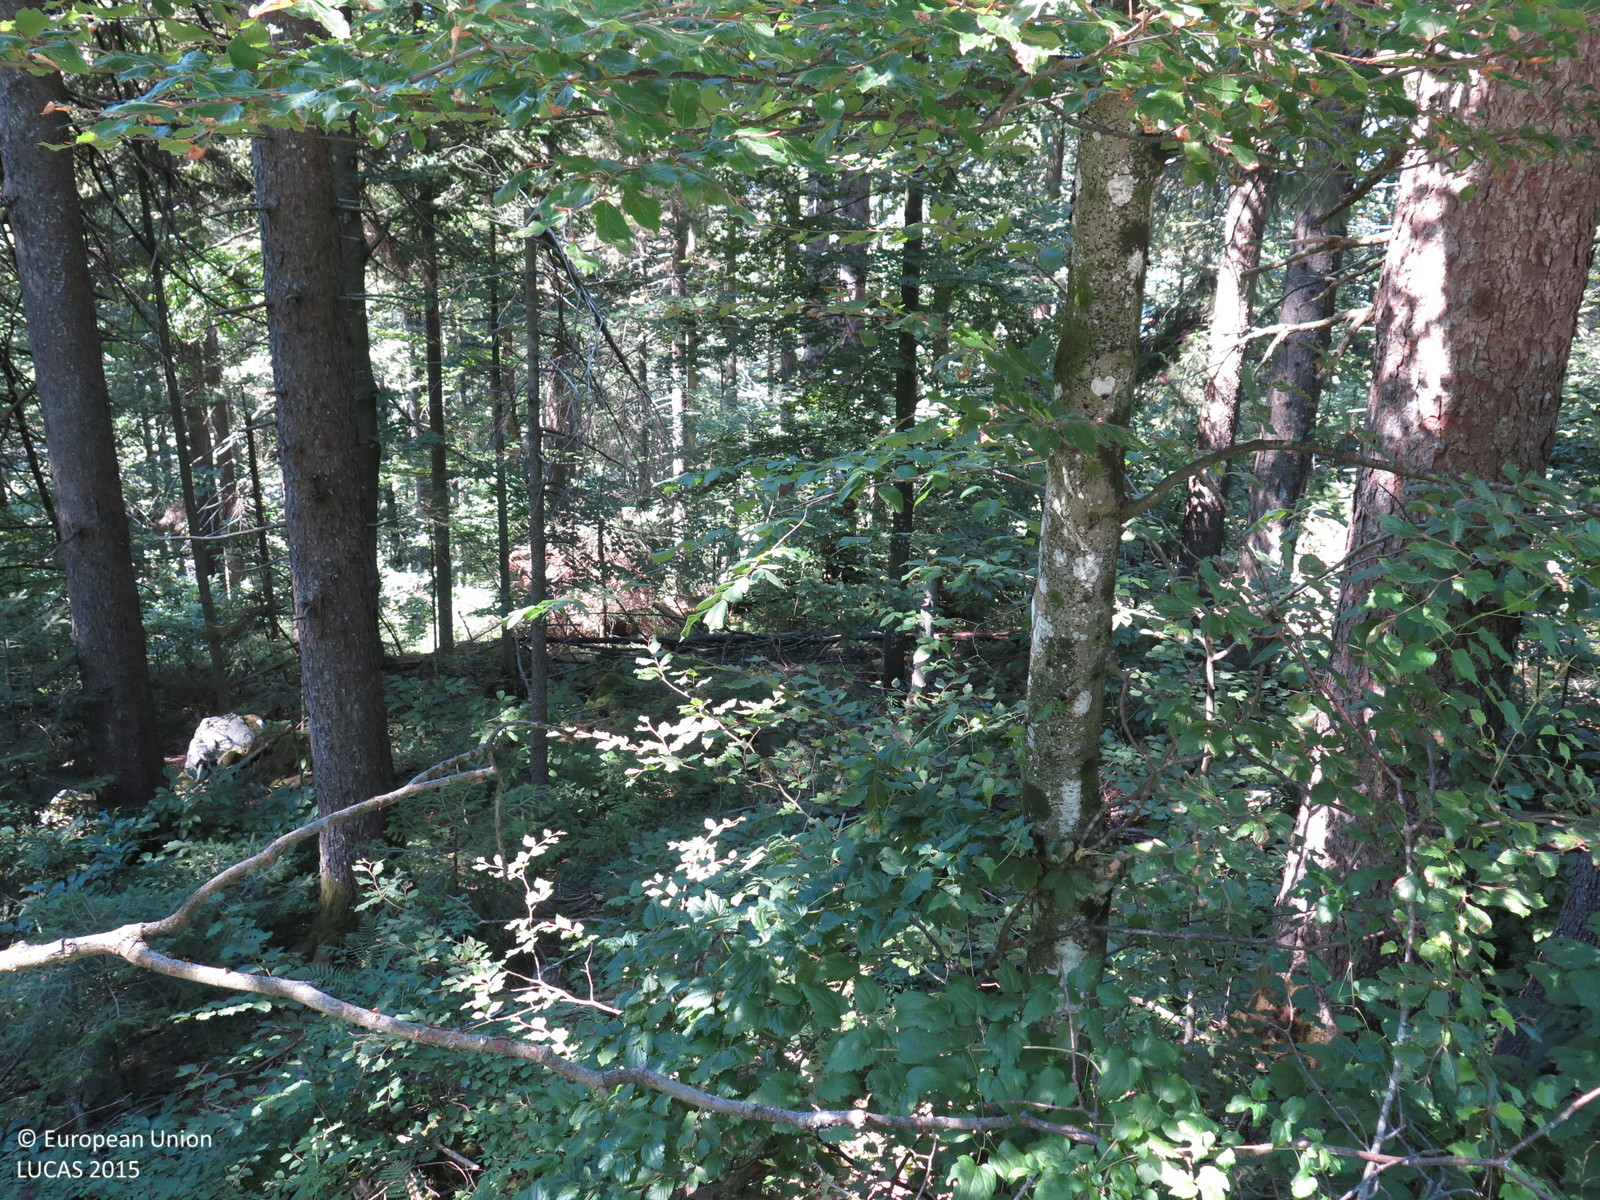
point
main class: Woodland
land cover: Other mixed woodland
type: mountainous beech forest
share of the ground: > 75 %
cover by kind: coniferous forest trees 75 %, broadleaved forest trees 25 %
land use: Forestry
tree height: > 5 m
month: August
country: HR
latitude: 45.3431
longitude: 14.7554
